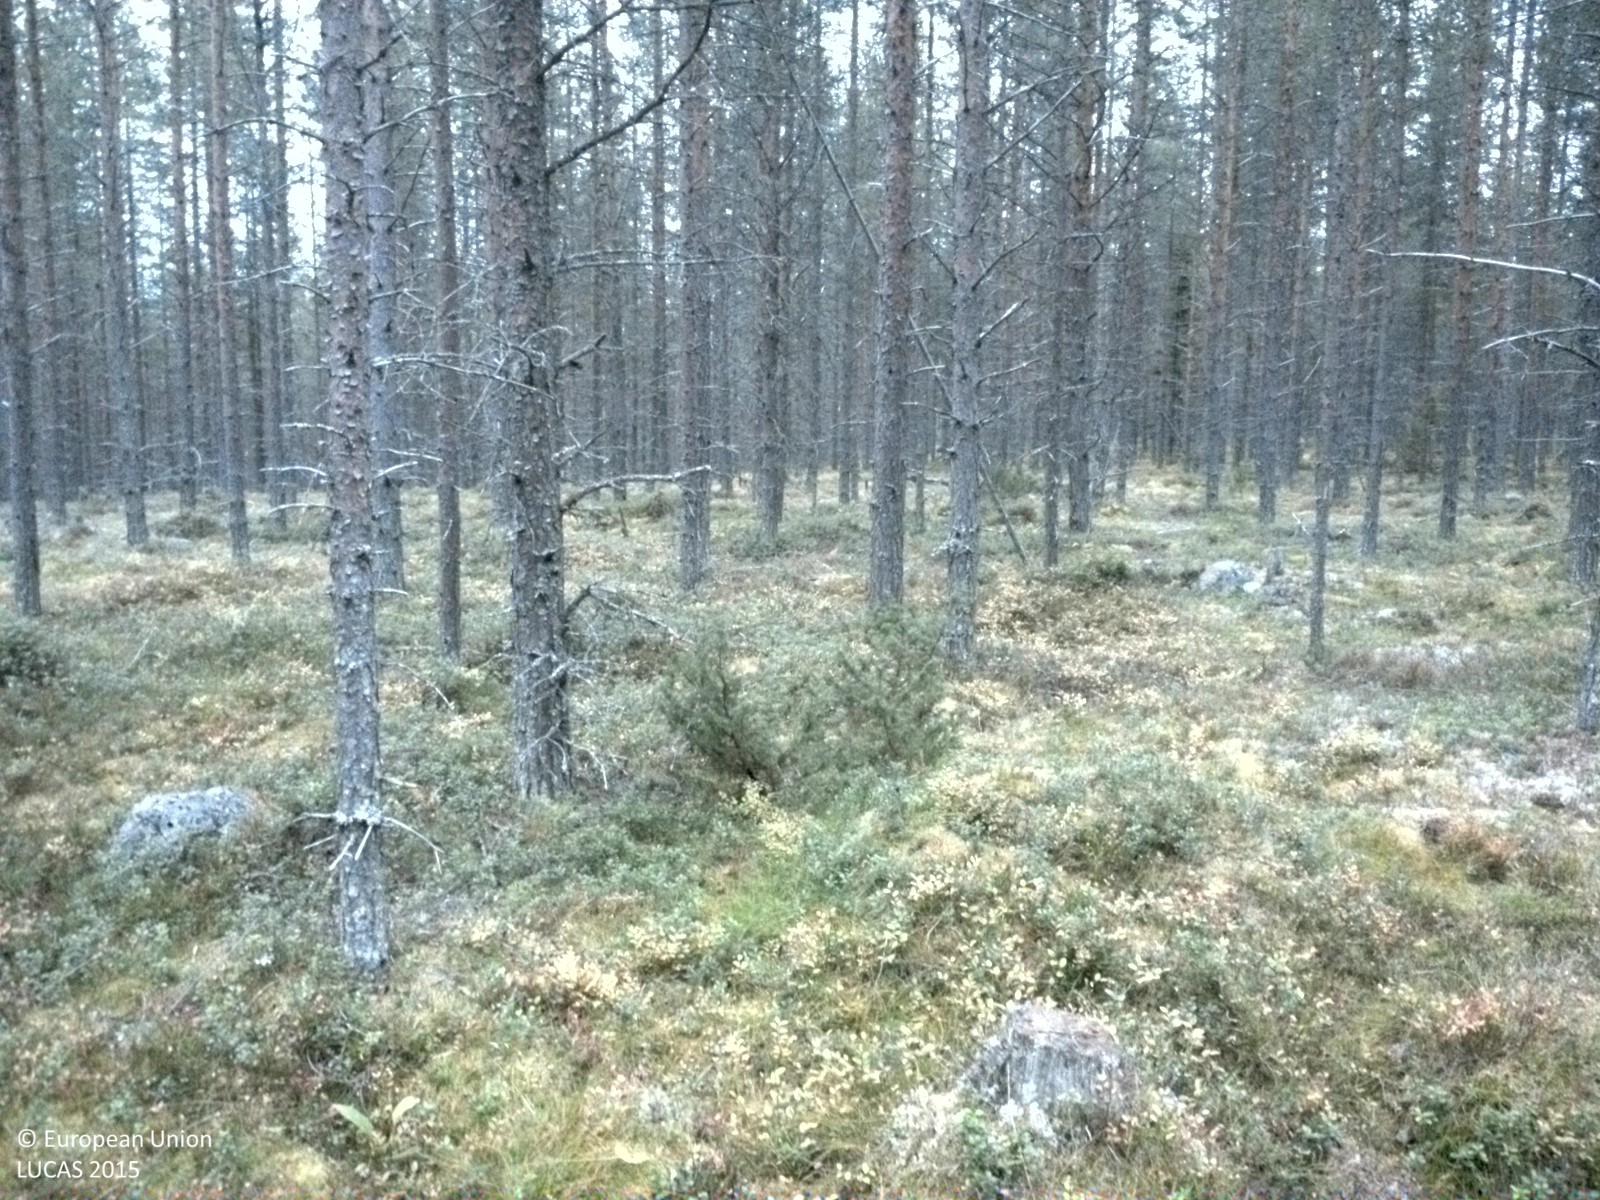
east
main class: Woodland
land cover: Pine dominated coniferous woodland
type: boreal forest
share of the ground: 25 - 50 %
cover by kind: shrubs 60 %, coniferous forest trees 35 %, lichens and mosses 5 %
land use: Forestry
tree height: > 5 m
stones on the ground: 25 - 50 %
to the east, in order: Pine dominated coniferous woodland; Tracks; Pine dominated coniferous woodland
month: October
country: SE
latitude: 65.7171
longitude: 20.4028
